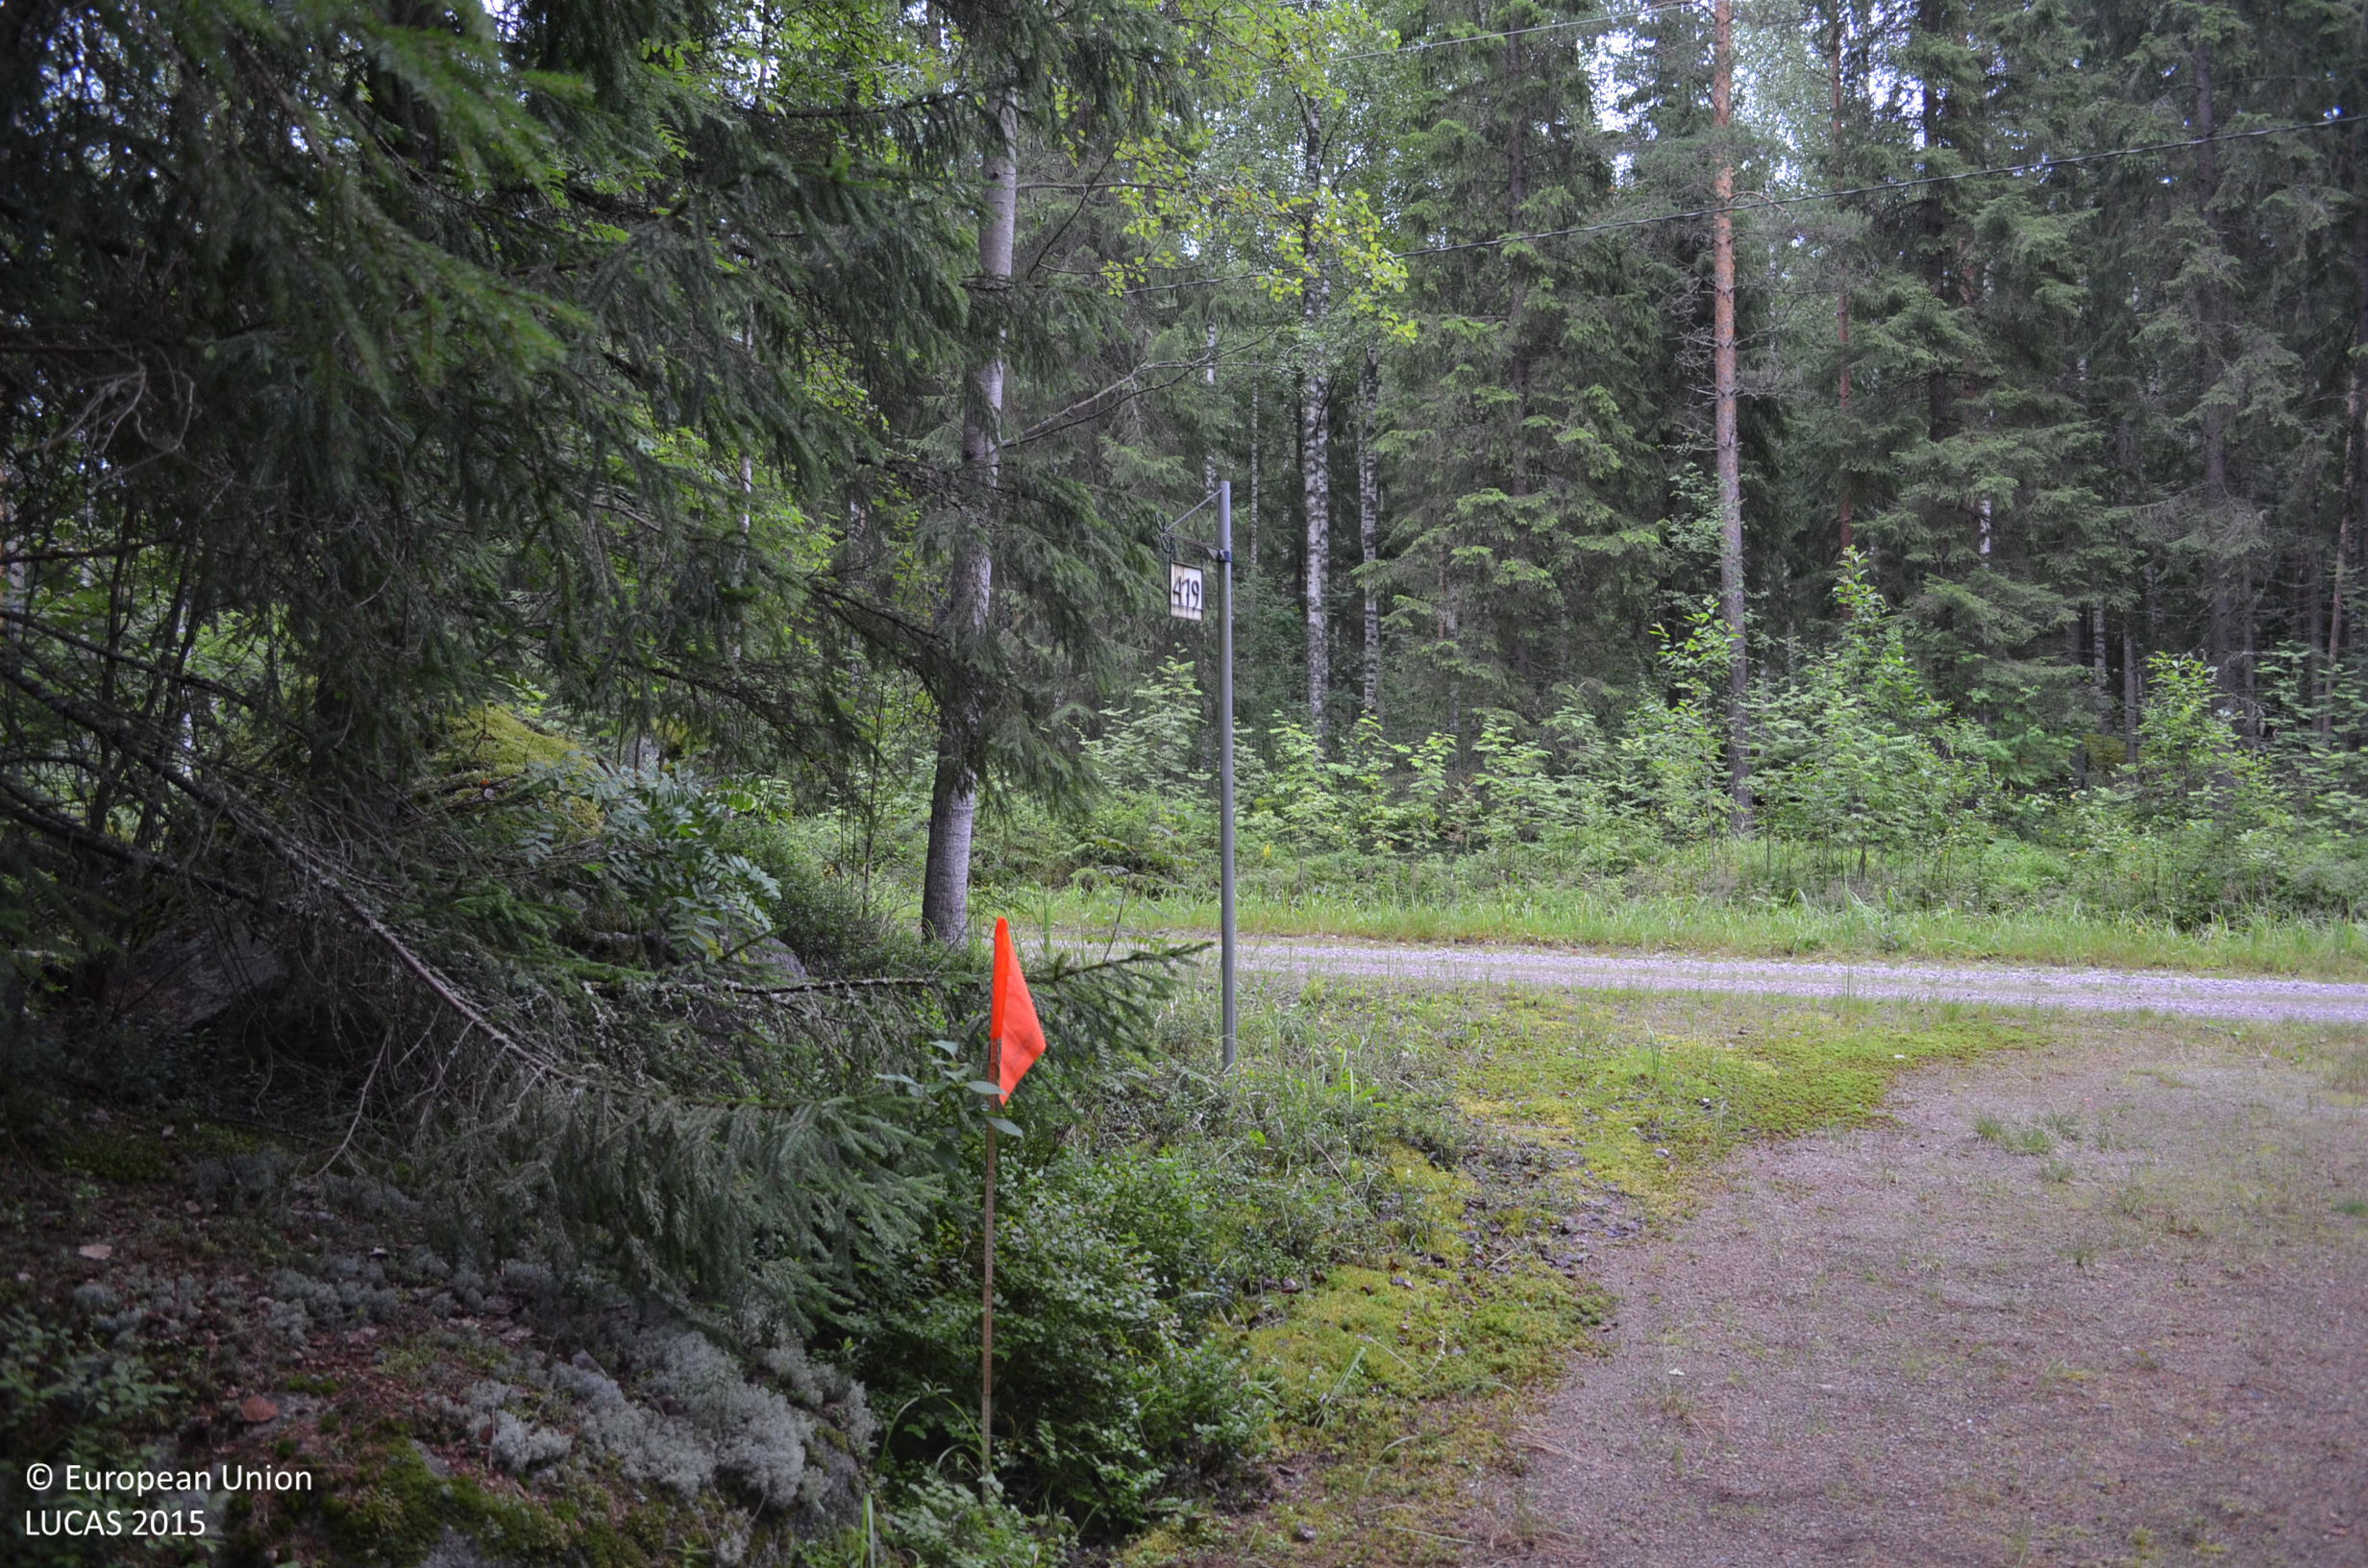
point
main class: Woodland
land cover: Spruce dominated coniferous woodland
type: boreal forest
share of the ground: > 75 %
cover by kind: coniferous forest trees 75 %, shrubs 15 %, broadleaved forest trees 10 %
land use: Forestry
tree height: > 5 m
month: July
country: FI
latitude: 62.0363
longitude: 24.0983
